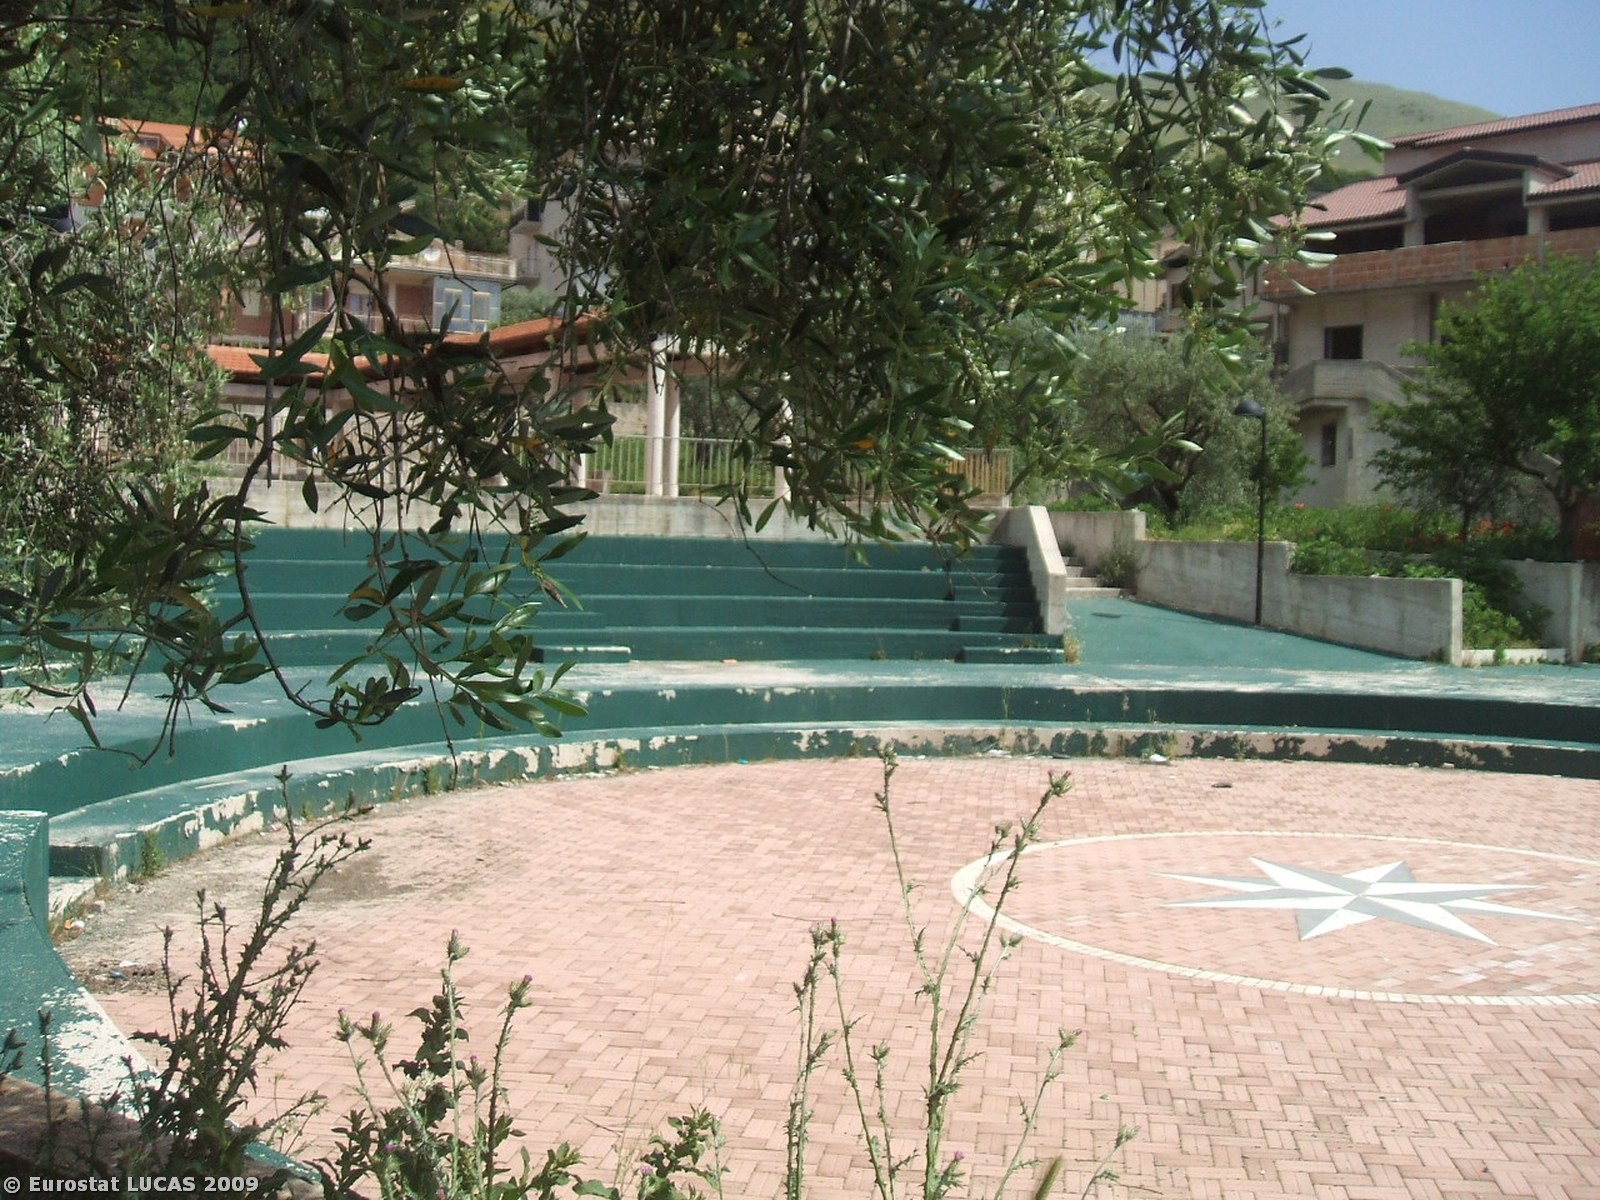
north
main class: Cropland
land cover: Olive groves
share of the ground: 25 - 50 %
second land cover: Spontaneously vegetated surfaces
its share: > 75 %
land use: Agriculture (excluding fallow land and kitchen gardens)
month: May
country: IT
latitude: 40.3462
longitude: 15.5453
